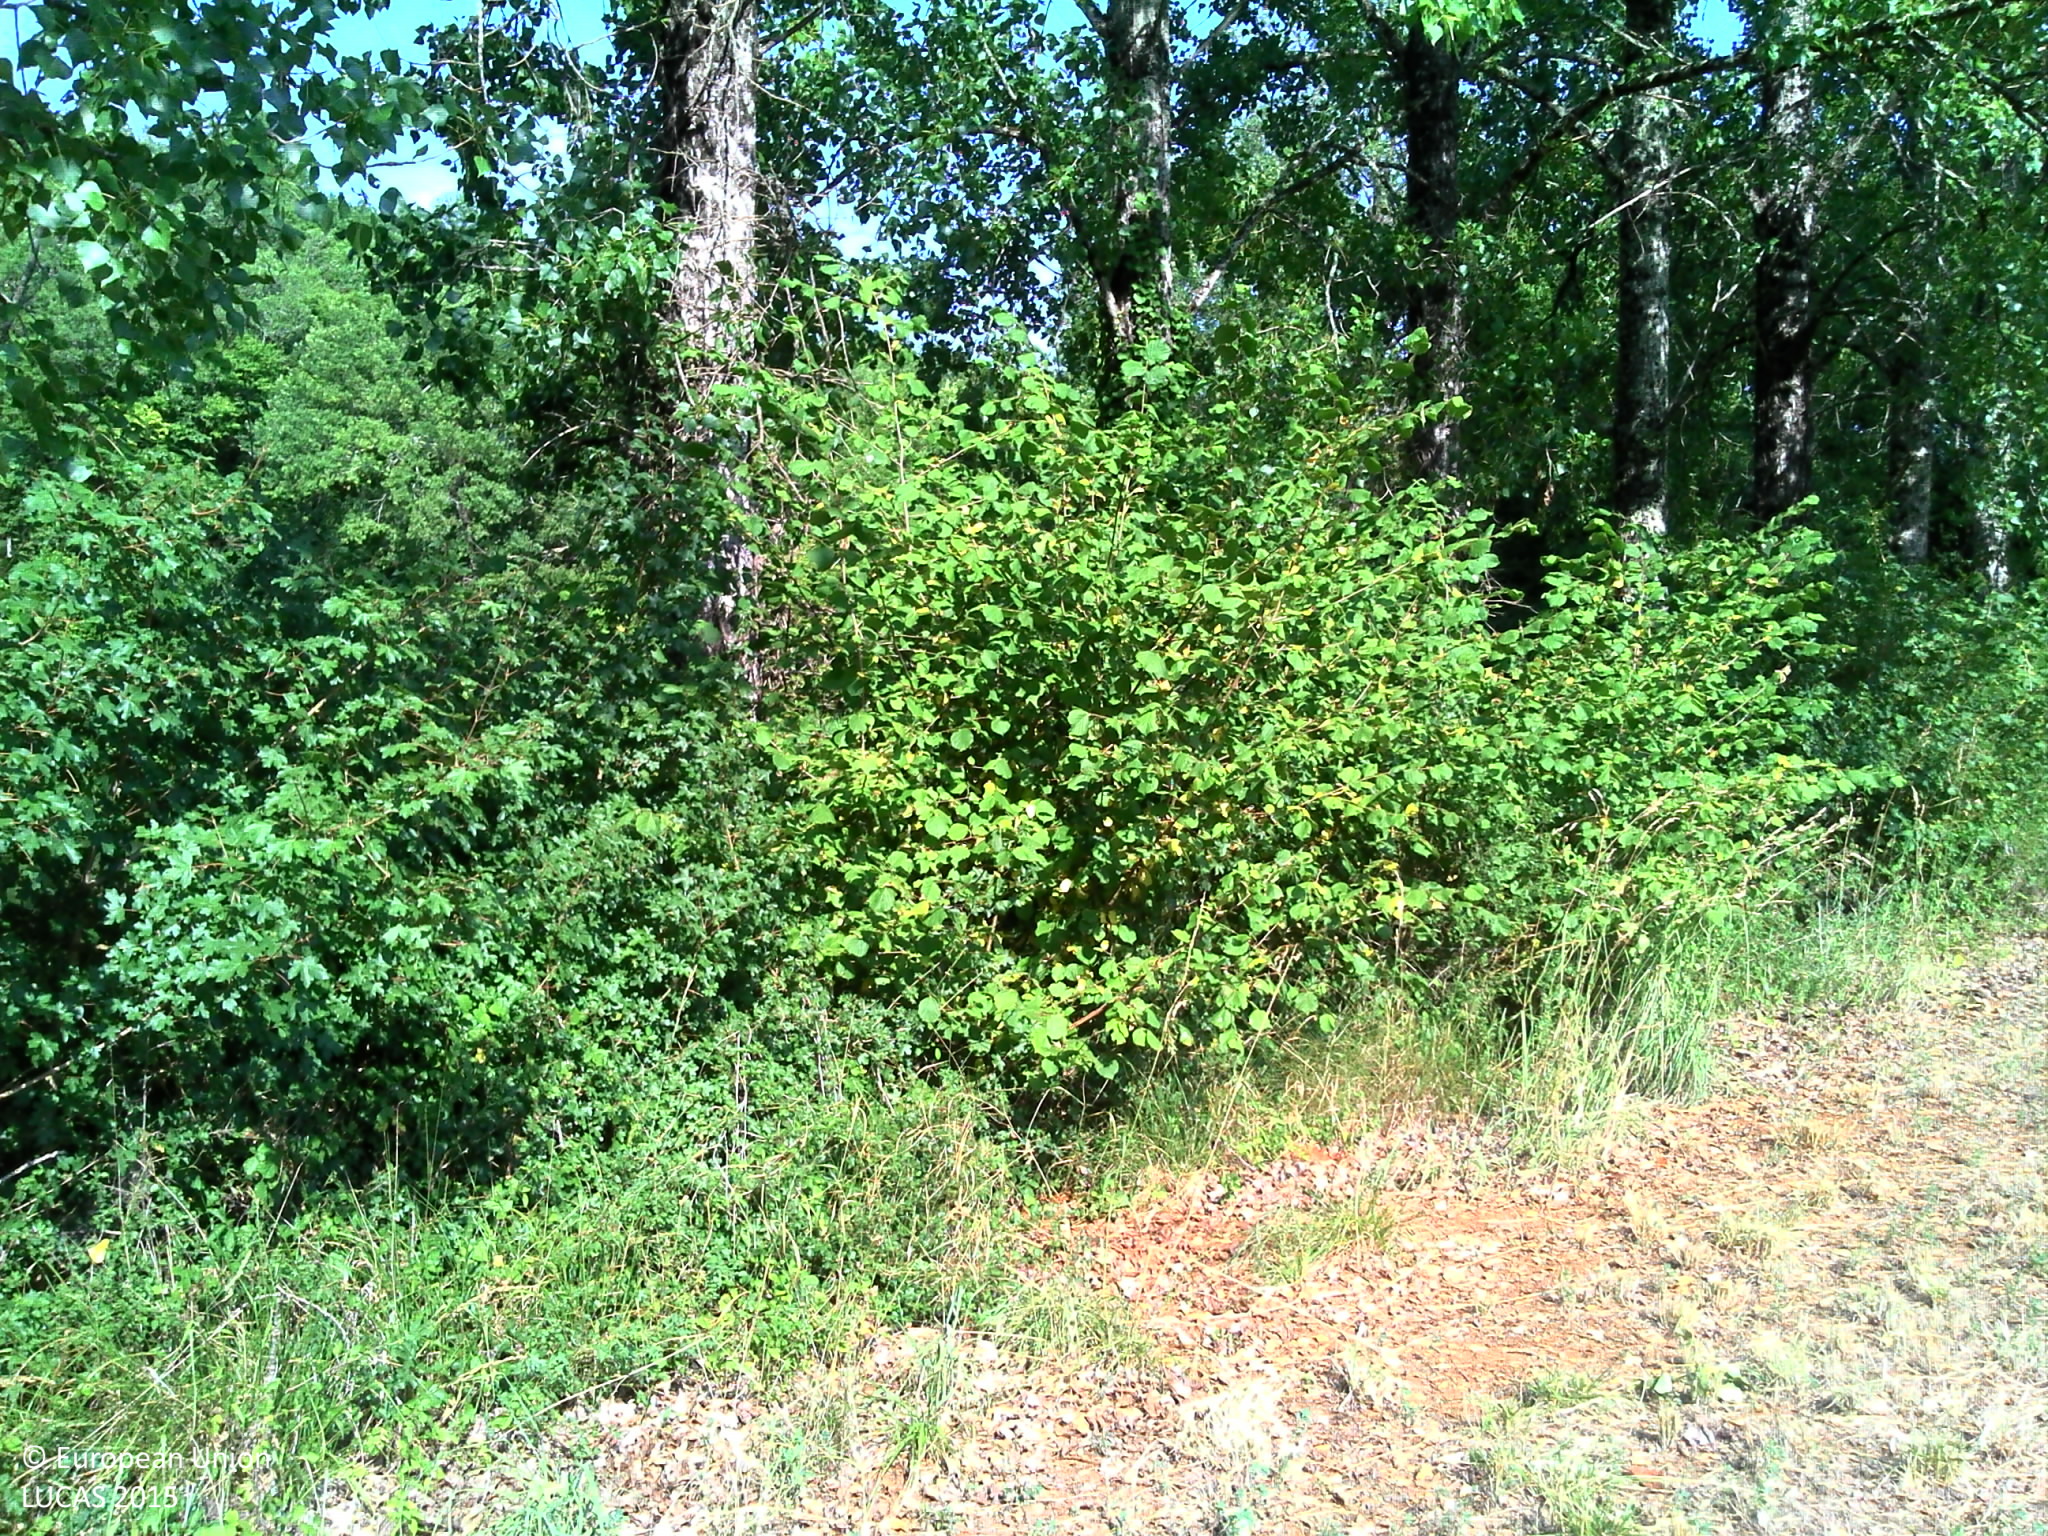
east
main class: Cropland
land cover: Temporary grasslands
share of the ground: > 75 %
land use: Agriculture (excluding fallow land and kitchen gardens)
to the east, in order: Temporary grasslands; Abandoned hedges; Grassland without tree/shrub cover; Inland fresh water bodies; Grass margins; Grassland with sparse tree/shrub cover; Tracks; Broadleaved woodland
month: July
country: FR
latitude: 45.2378
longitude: 1.1136
